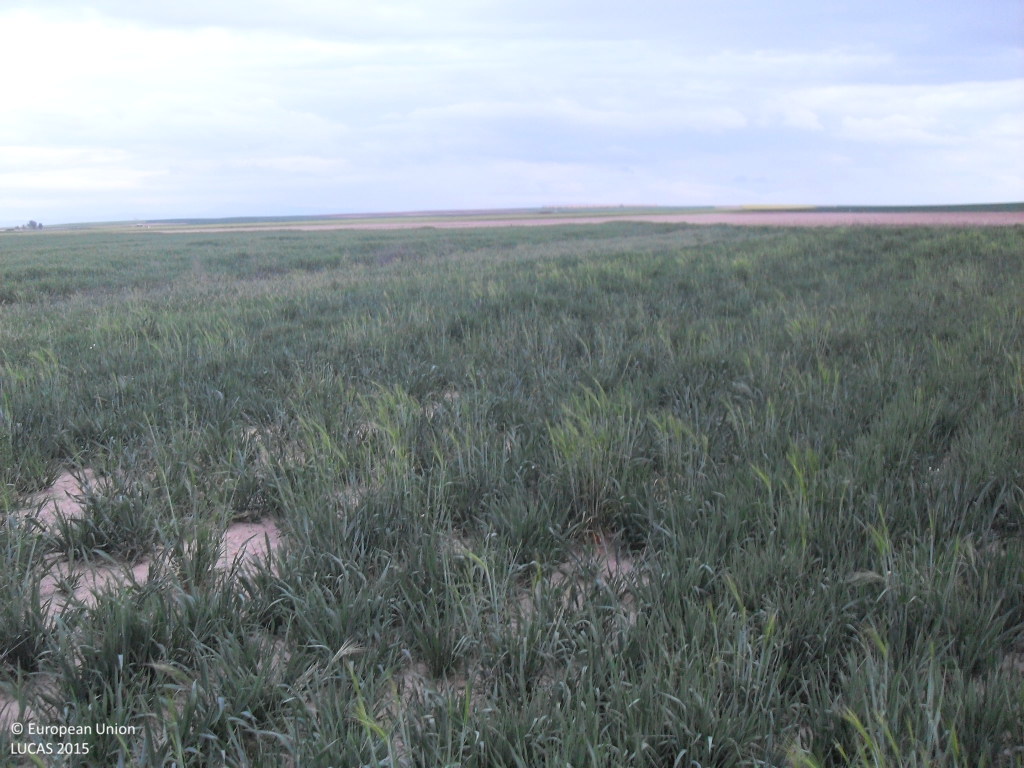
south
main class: Cropland
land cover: Oats
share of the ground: > 75 %
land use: Agriculture (excluding fallow land and kitchen gardens)
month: April
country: ES
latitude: 40.9781
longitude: -5.2461
